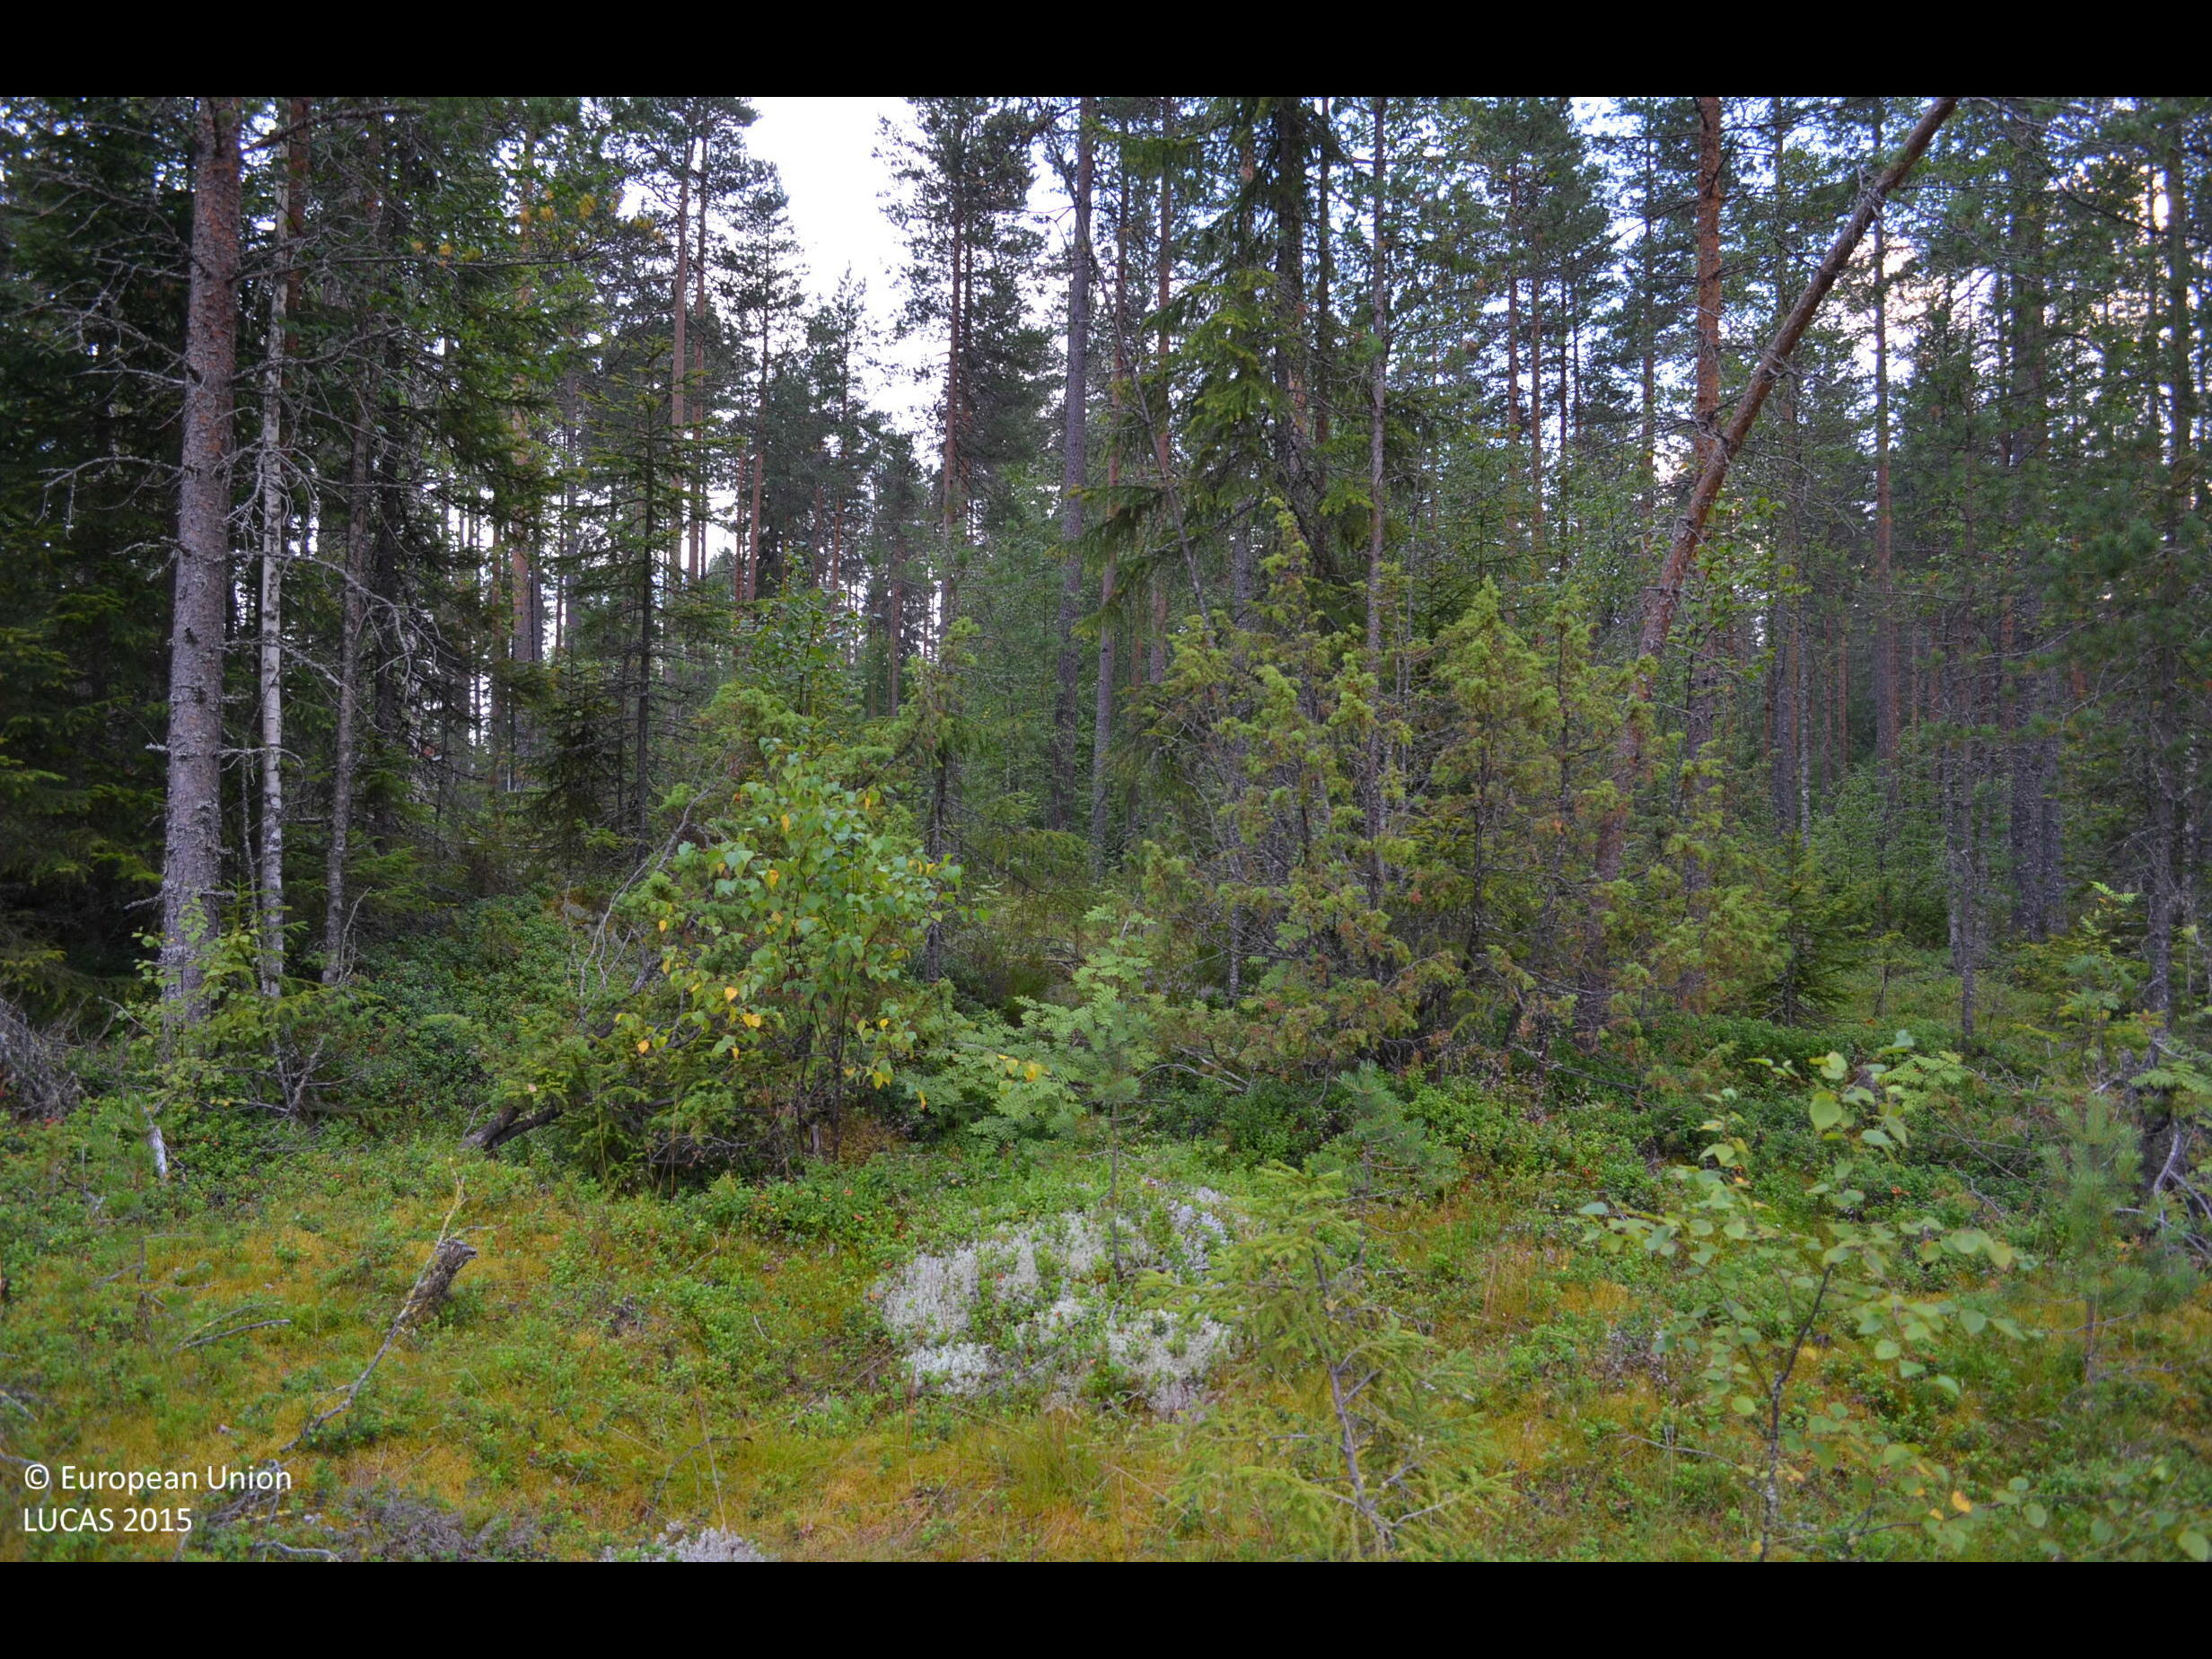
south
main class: Artificial land
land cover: Other artificial areas
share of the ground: < 10 %
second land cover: Other mixed woodland
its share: 25 - 50 %
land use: Electricity, gas and thermal power distribution
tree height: < 5 m
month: August
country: FI
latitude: 62.2753
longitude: 24.2879
